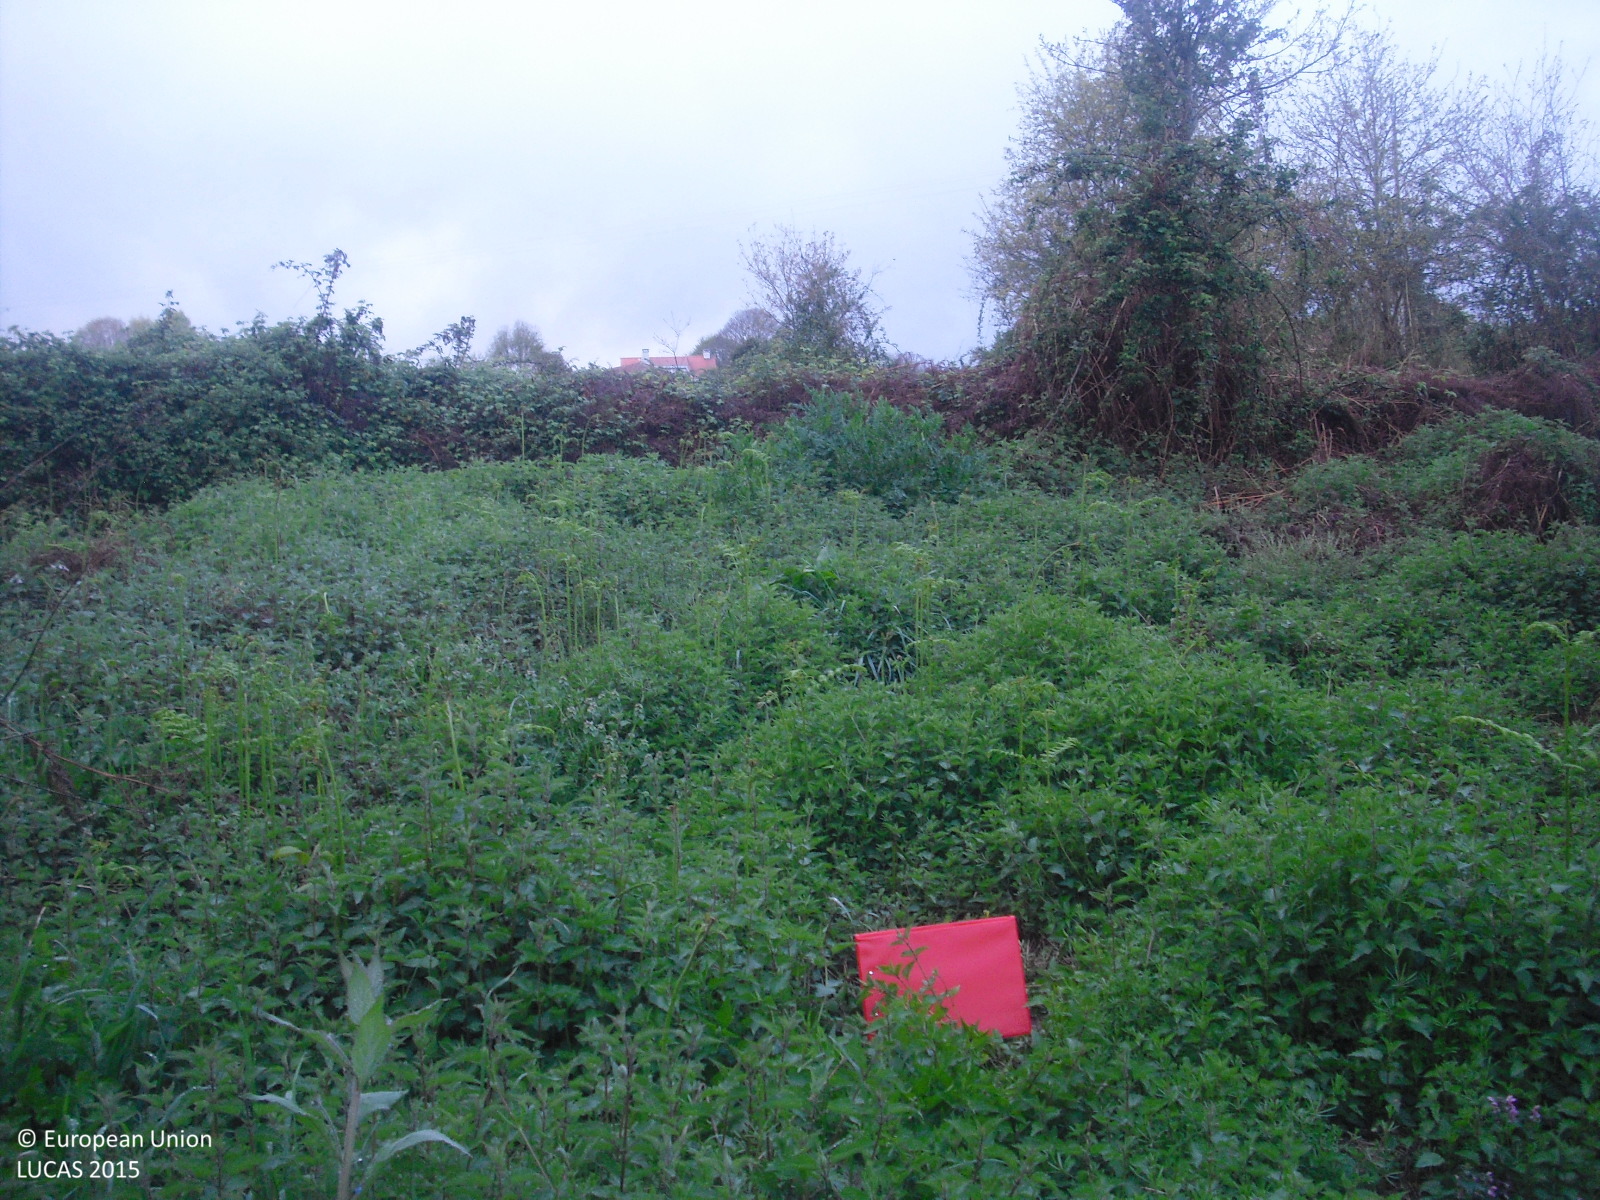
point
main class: Grassland
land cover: Grassland with sparse tree/shrub cover
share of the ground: > 75 %
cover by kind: herbaceous plants 85 %, shrubs 10 %, broadleaved forest trees 5 %
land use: Semi-natural and natural areas not in use
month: April
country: ES
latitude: 42.1071
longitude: -7.8379
